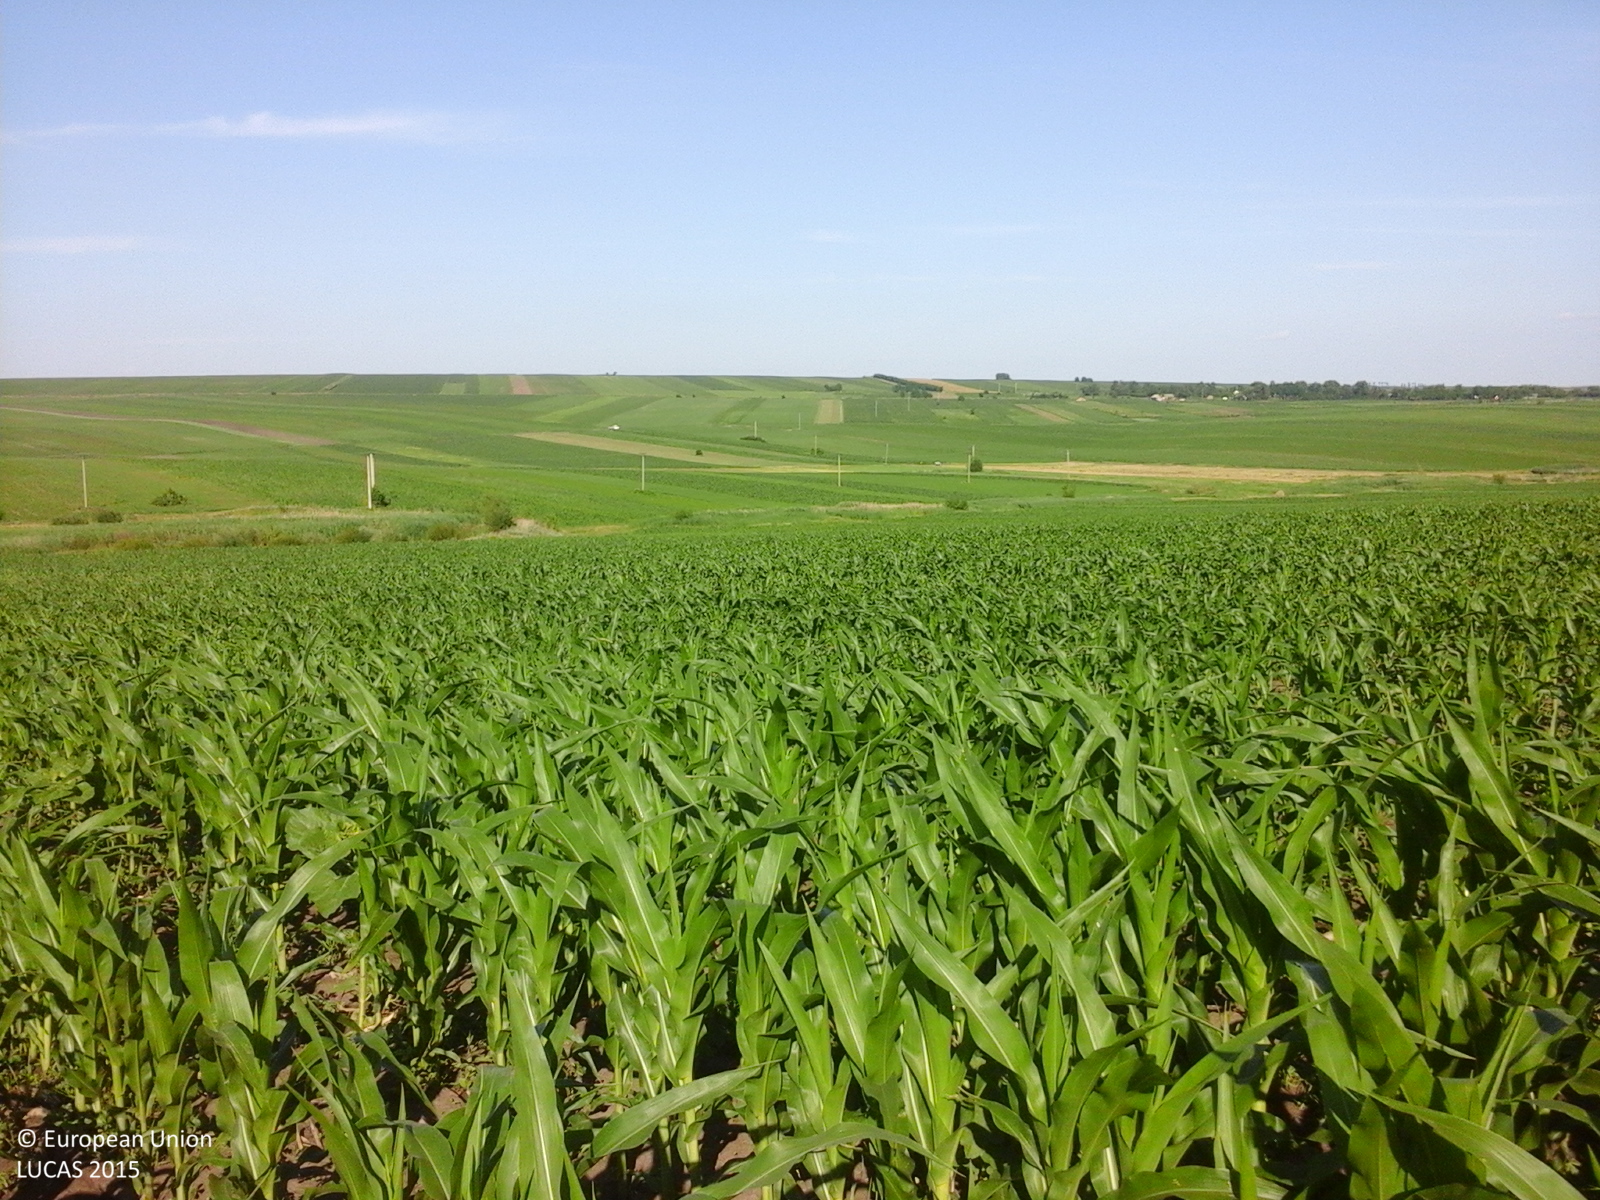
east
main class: Cropland
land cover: Maize
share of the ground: 50 - 75 %
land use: Agriculture (excluding fallow land and kitchen gardens)
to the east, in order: Maize; Grass margins; Tracks; Grass margins; Maize; Lucerne; Sunflower; Maize; Lucerne; Maize
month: June
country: RO
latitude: 47.6198
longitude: 27.1527
